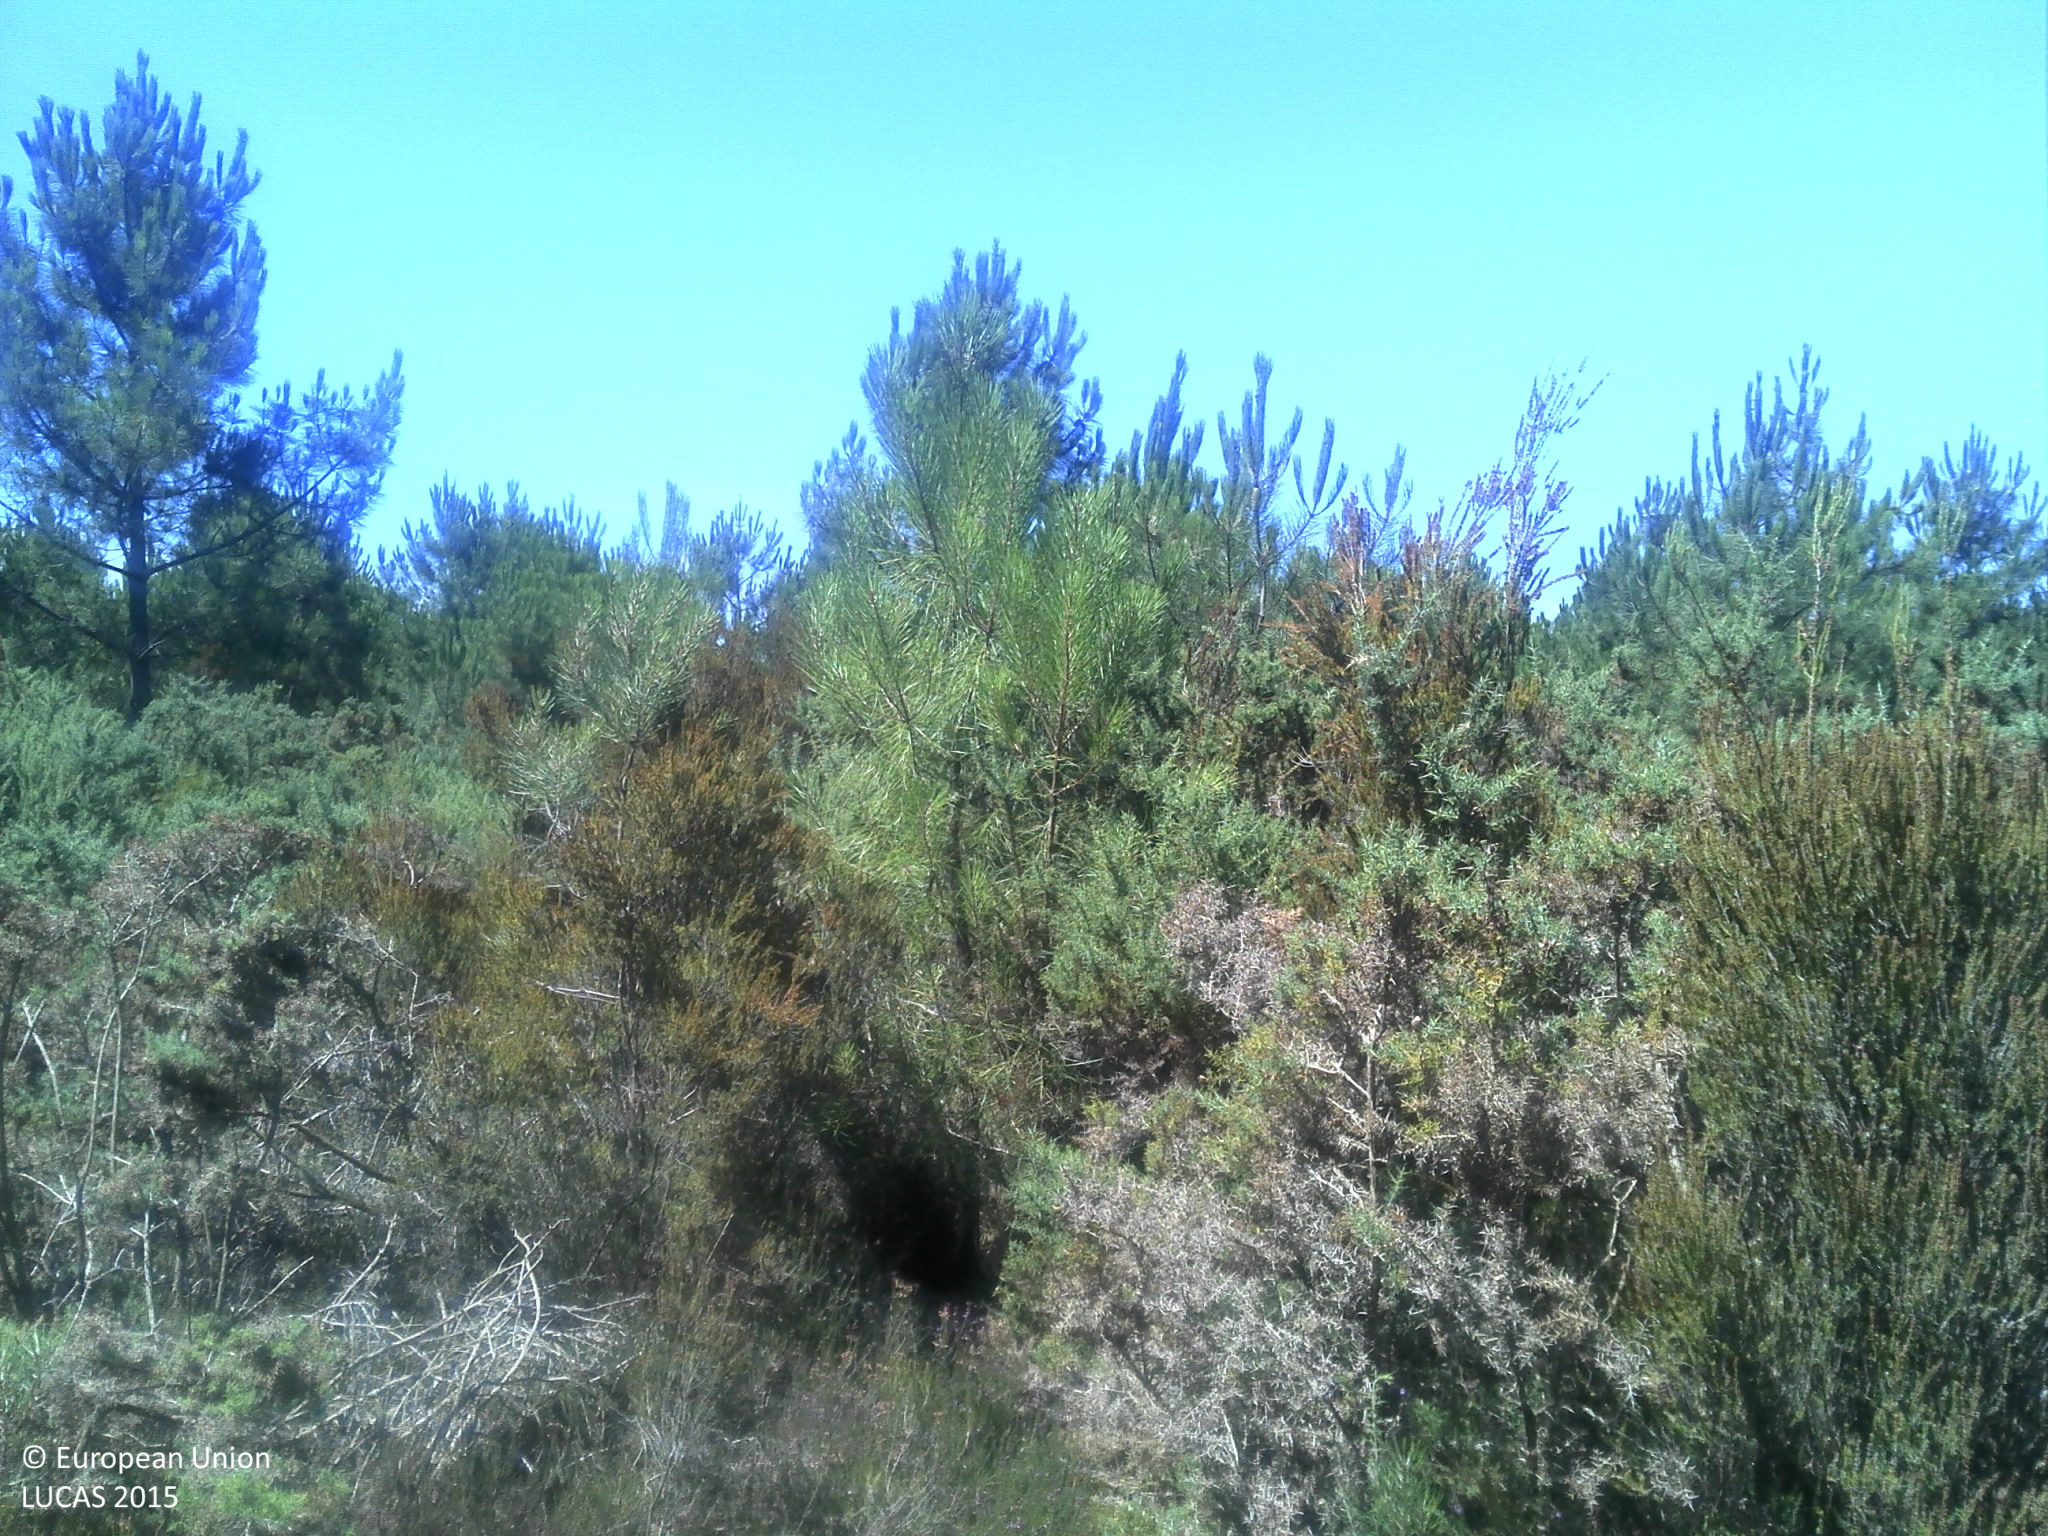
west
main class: Shrubland
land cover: Shrubland with sparse tree cover
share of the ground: > 75 %
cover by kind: shrubs 80 %, lichens and mosses 10 %, coniferous forest trees 5 %, unconsolidated bare surface 5 %
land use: Forestry
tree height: > 5 m
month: July
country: FR
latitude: 45.4227
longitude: -1.1336
